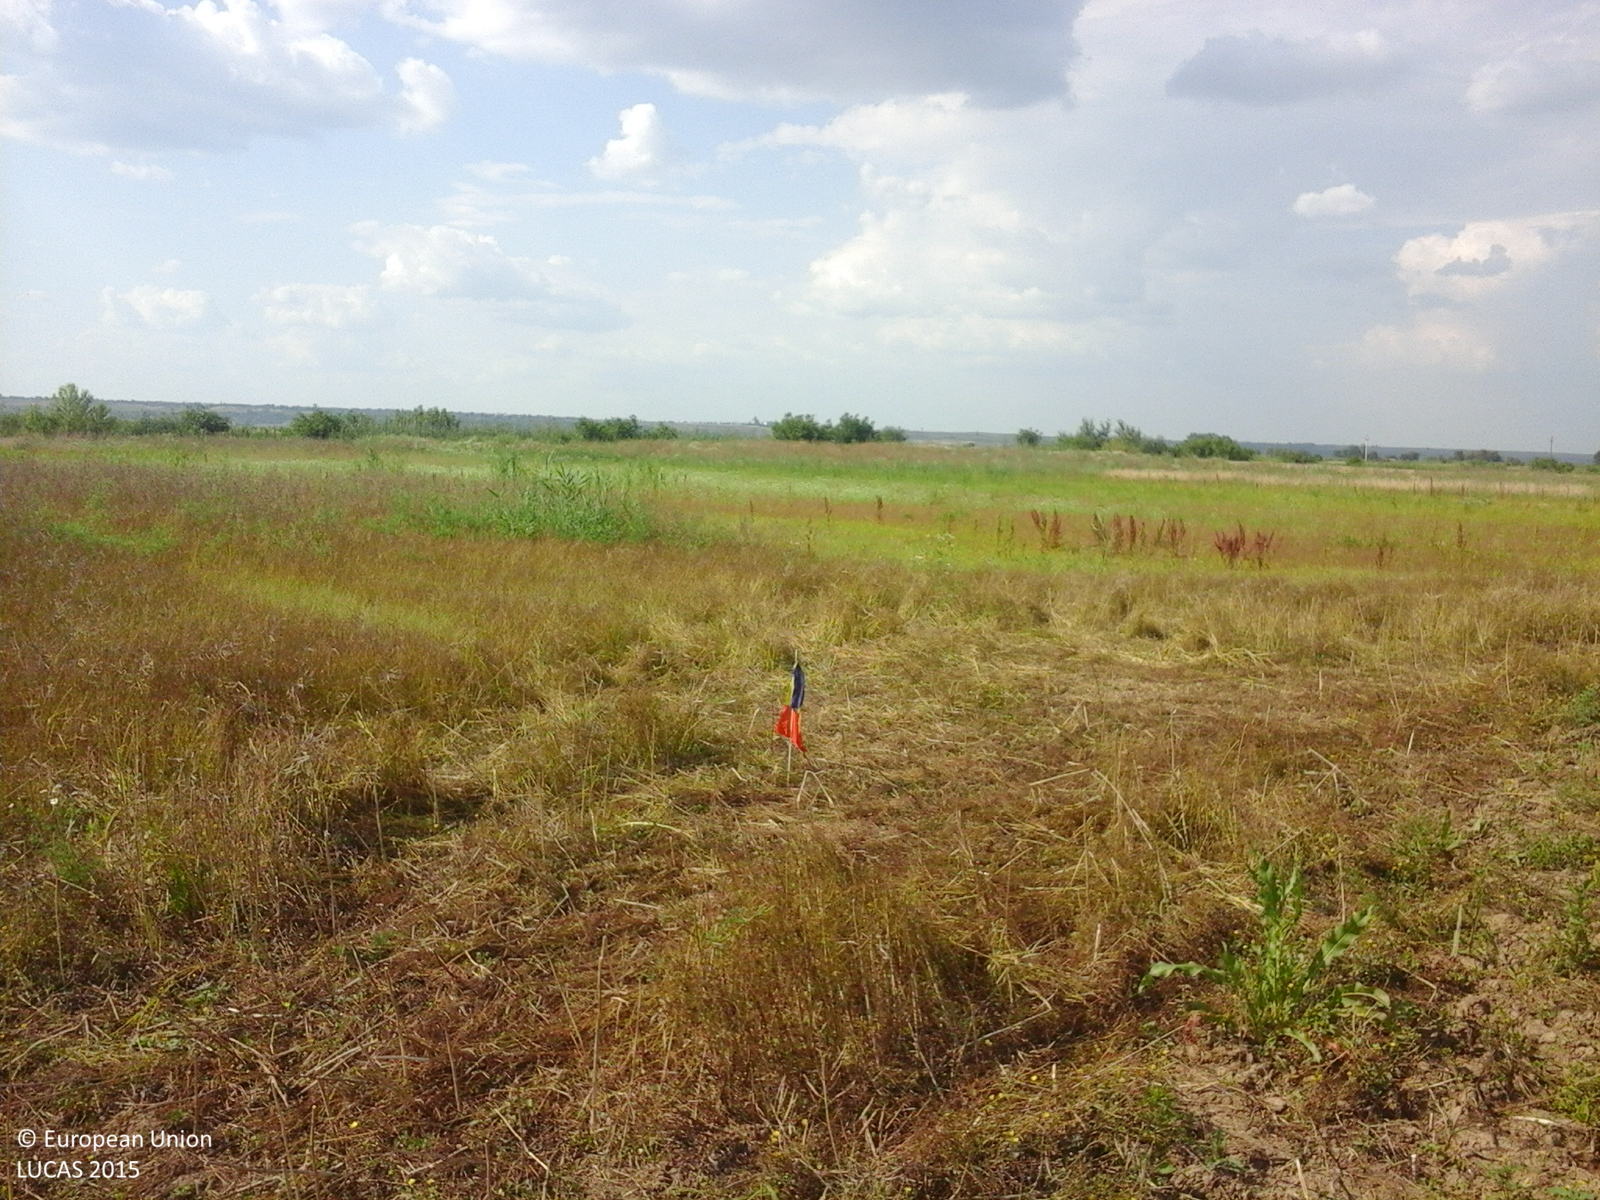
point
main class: Grassland
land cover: Spontaneously vegetated surfaces
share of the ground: > 75 %
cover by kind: herbaceous plants 100 %
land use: Fallow land
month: July
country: RO
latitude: 44.0014
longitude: 26.1011
